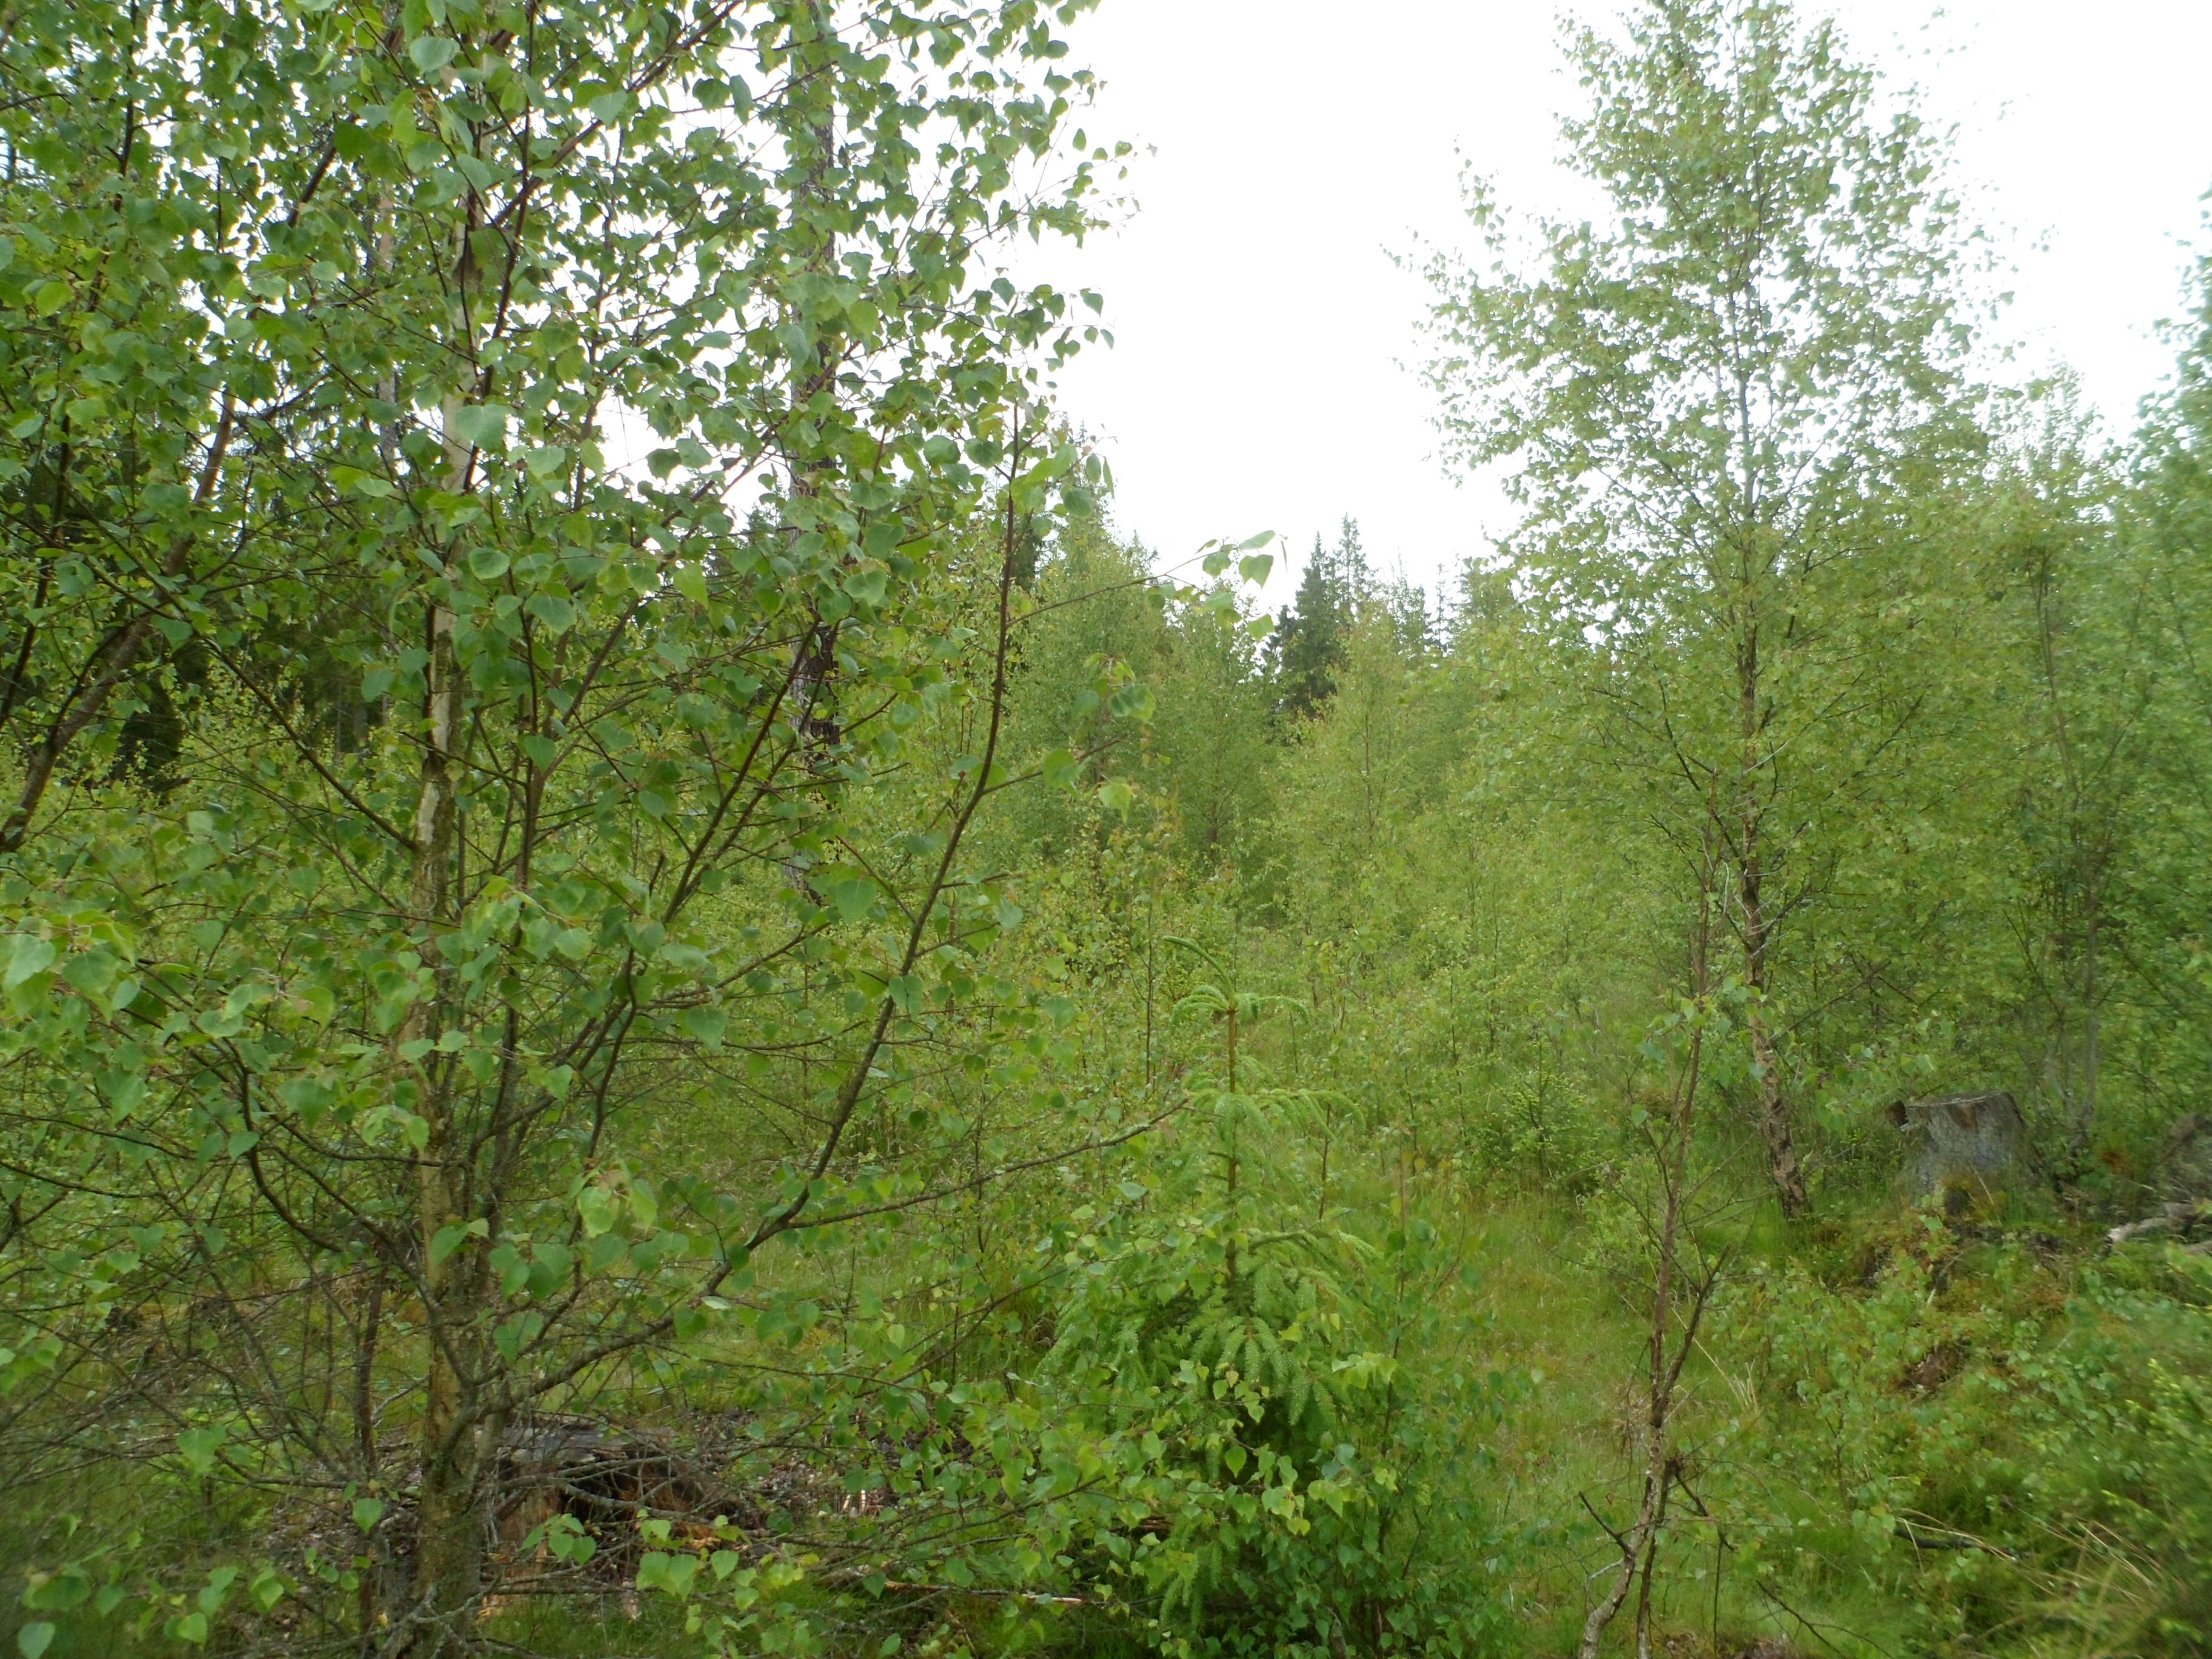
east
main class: Woodland
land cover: Broadleaved woodland
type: boreal forest
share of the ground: > 75 %
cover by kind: broadleaved forest trees 75 %, herbaceous plants 10 %, coniferous forest trees 5 %, shrubs 5 %, lichens and mosses 5 %
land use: Forestry
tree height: < 5 m
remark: Clear cut
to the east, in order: Broadleaved woodland; Spruce dominated mixed woodland; Spruce dominated coniferous woodland; Tracks; Spruce dominated coniferous woodland; Inland marshes; Inland fresh water bodies; Inland marshes
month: June
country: SE
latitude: 56.9154
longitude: 14.6124
